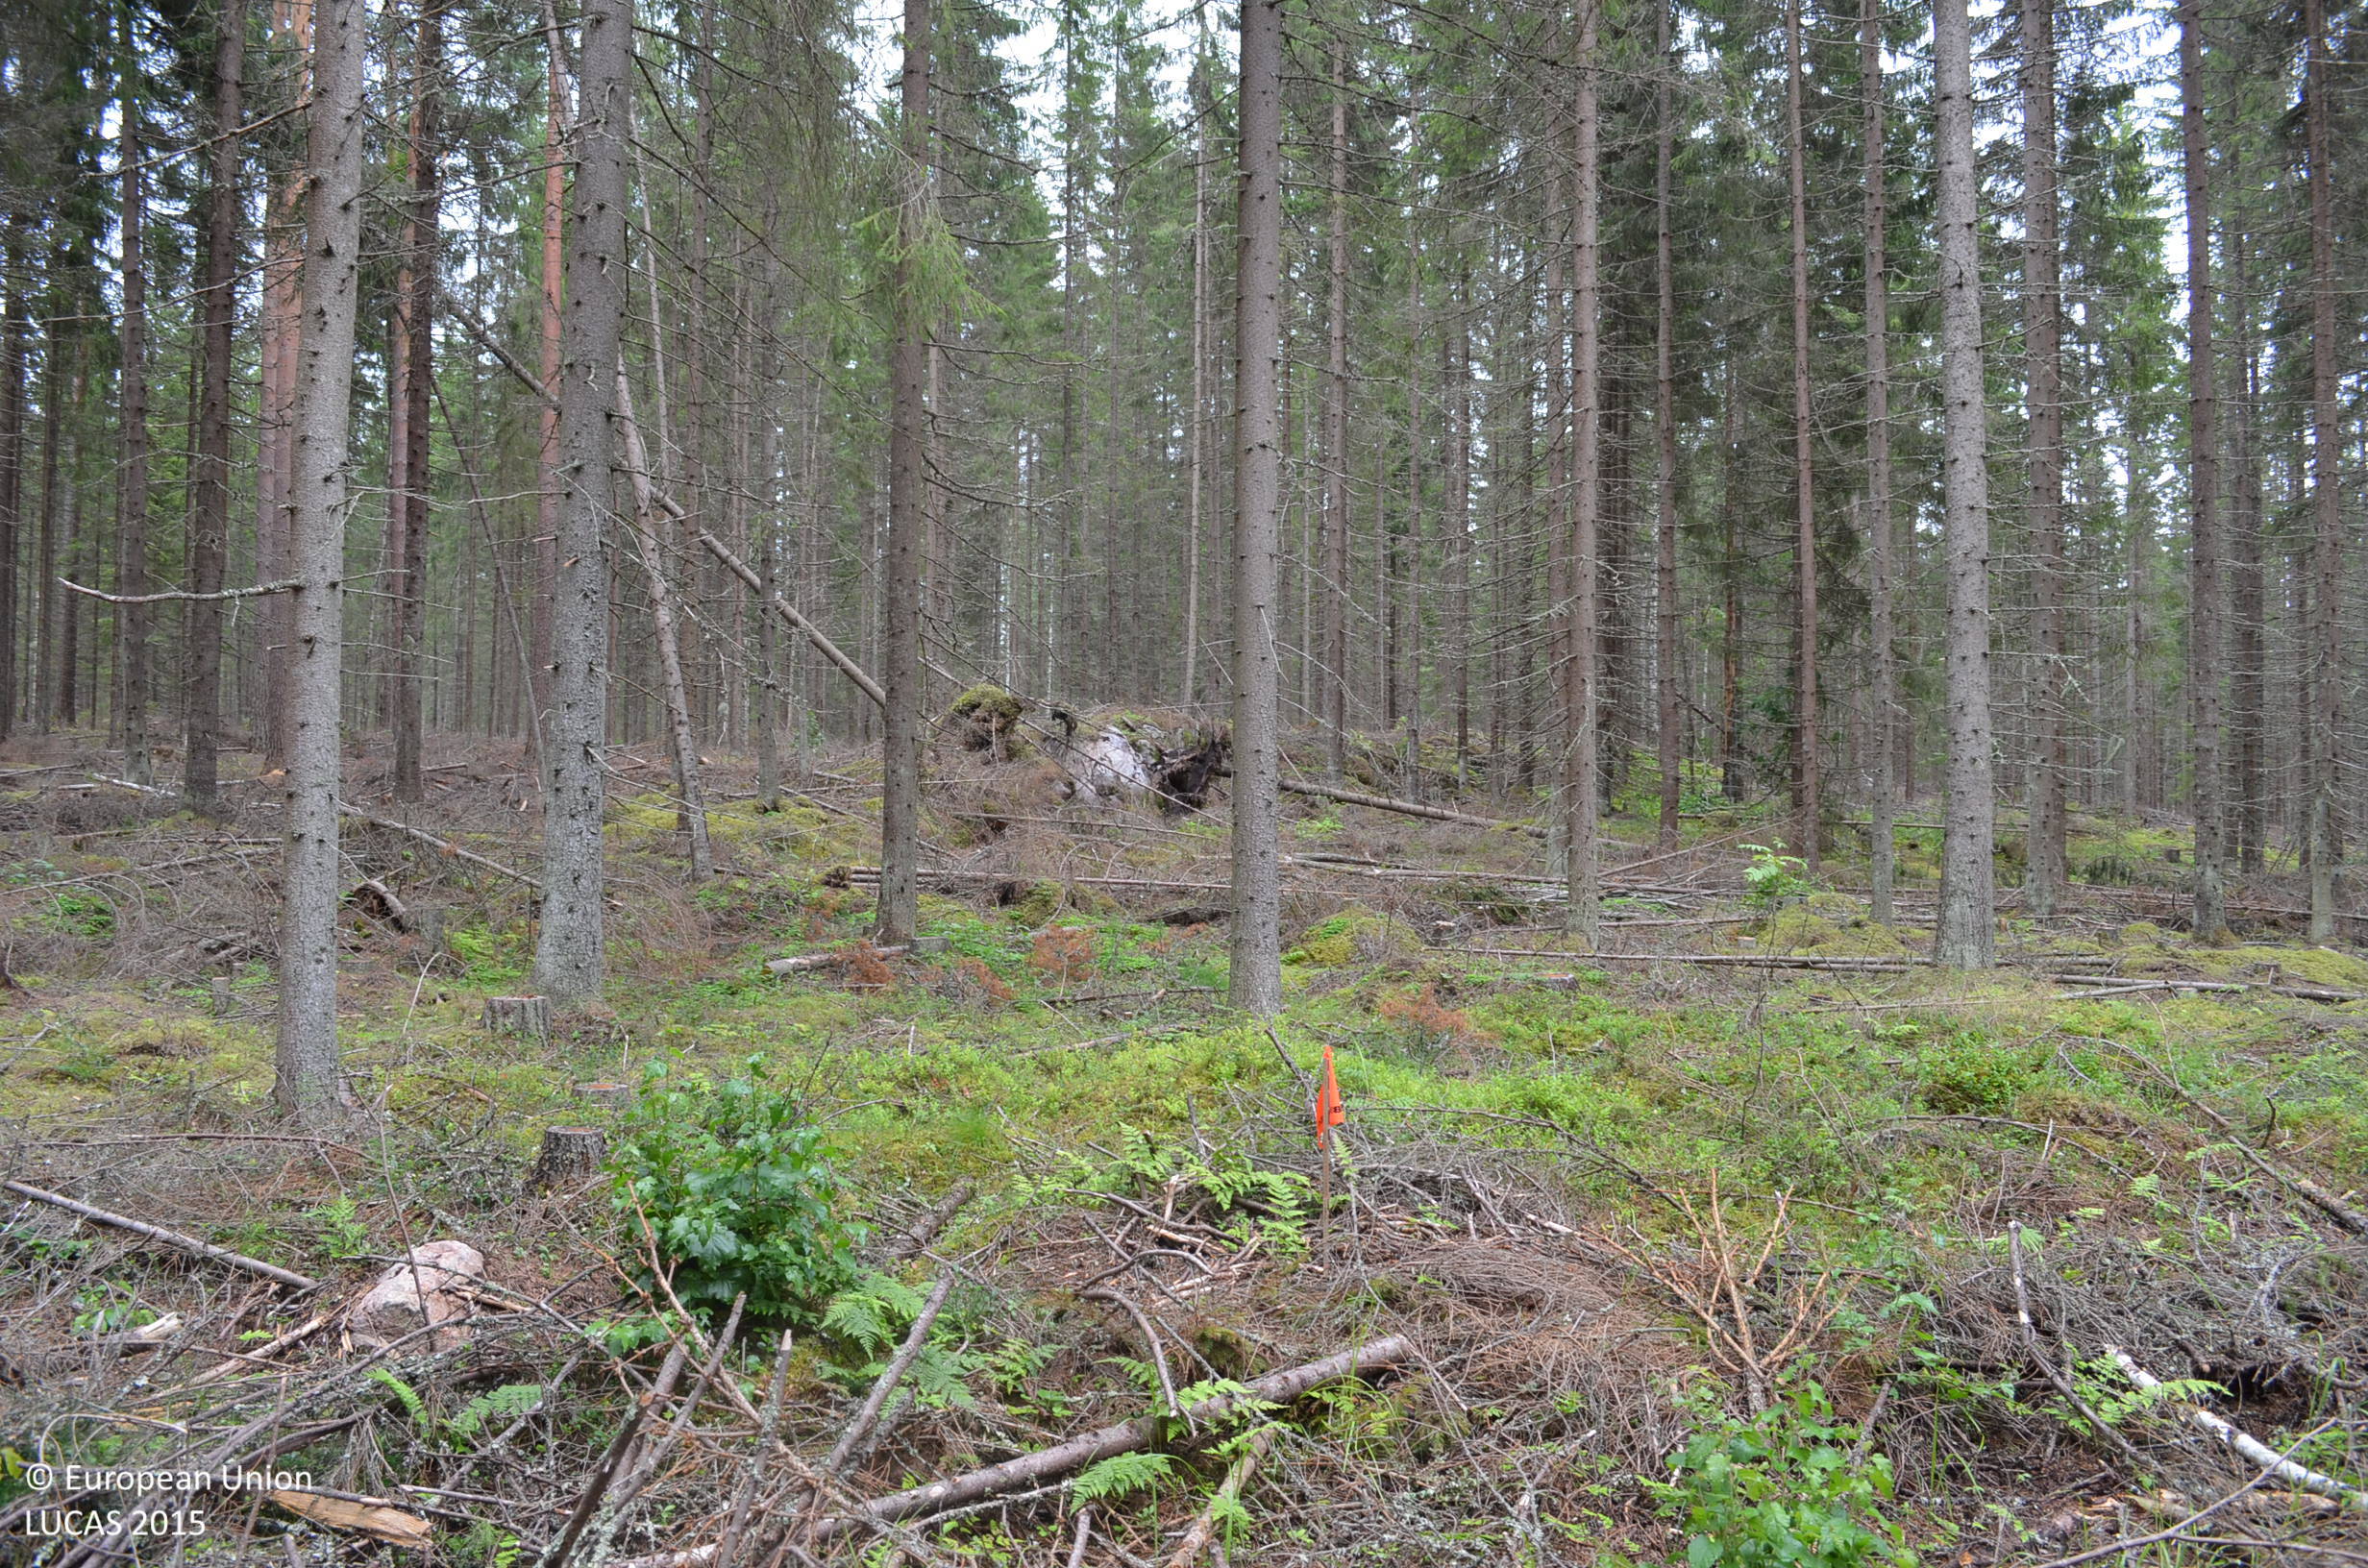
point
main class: Woodland
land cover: Spruce dominated coniferous woodland
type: boreal forest
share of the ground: 50 - 75 %
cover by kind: coniferous forest trees 65 %, shrubs 10 %, herbaceous plants 5 %, lichens and mosses 5 %
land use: Forestry
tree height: > 5 m
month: August
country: FI
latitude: 61.8919
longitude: 24.0711
